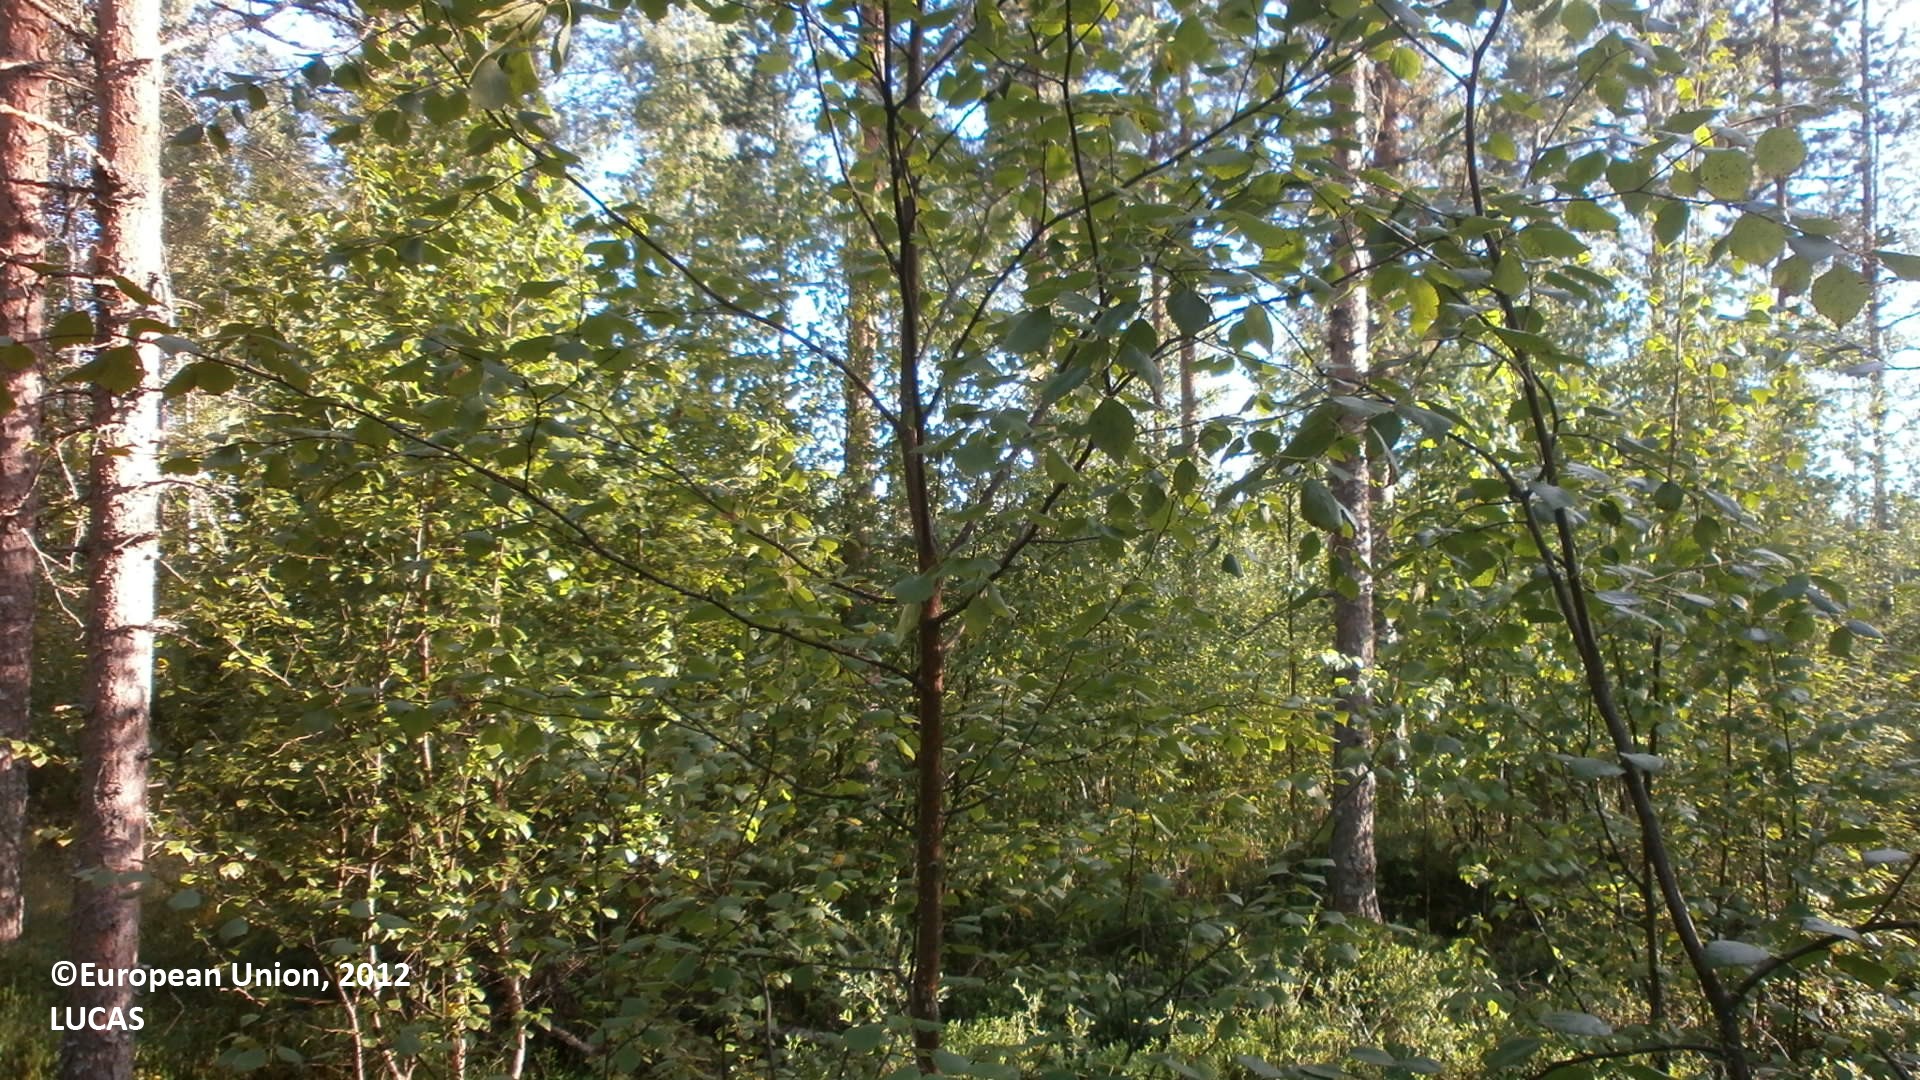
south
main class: Woodland
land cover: Pine dominated mixed woodland
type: boreal forest
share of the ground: > 75 %
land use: Forestry
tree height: > 5 m
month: July
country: FI
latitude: 64.0758
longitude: 24.3189
